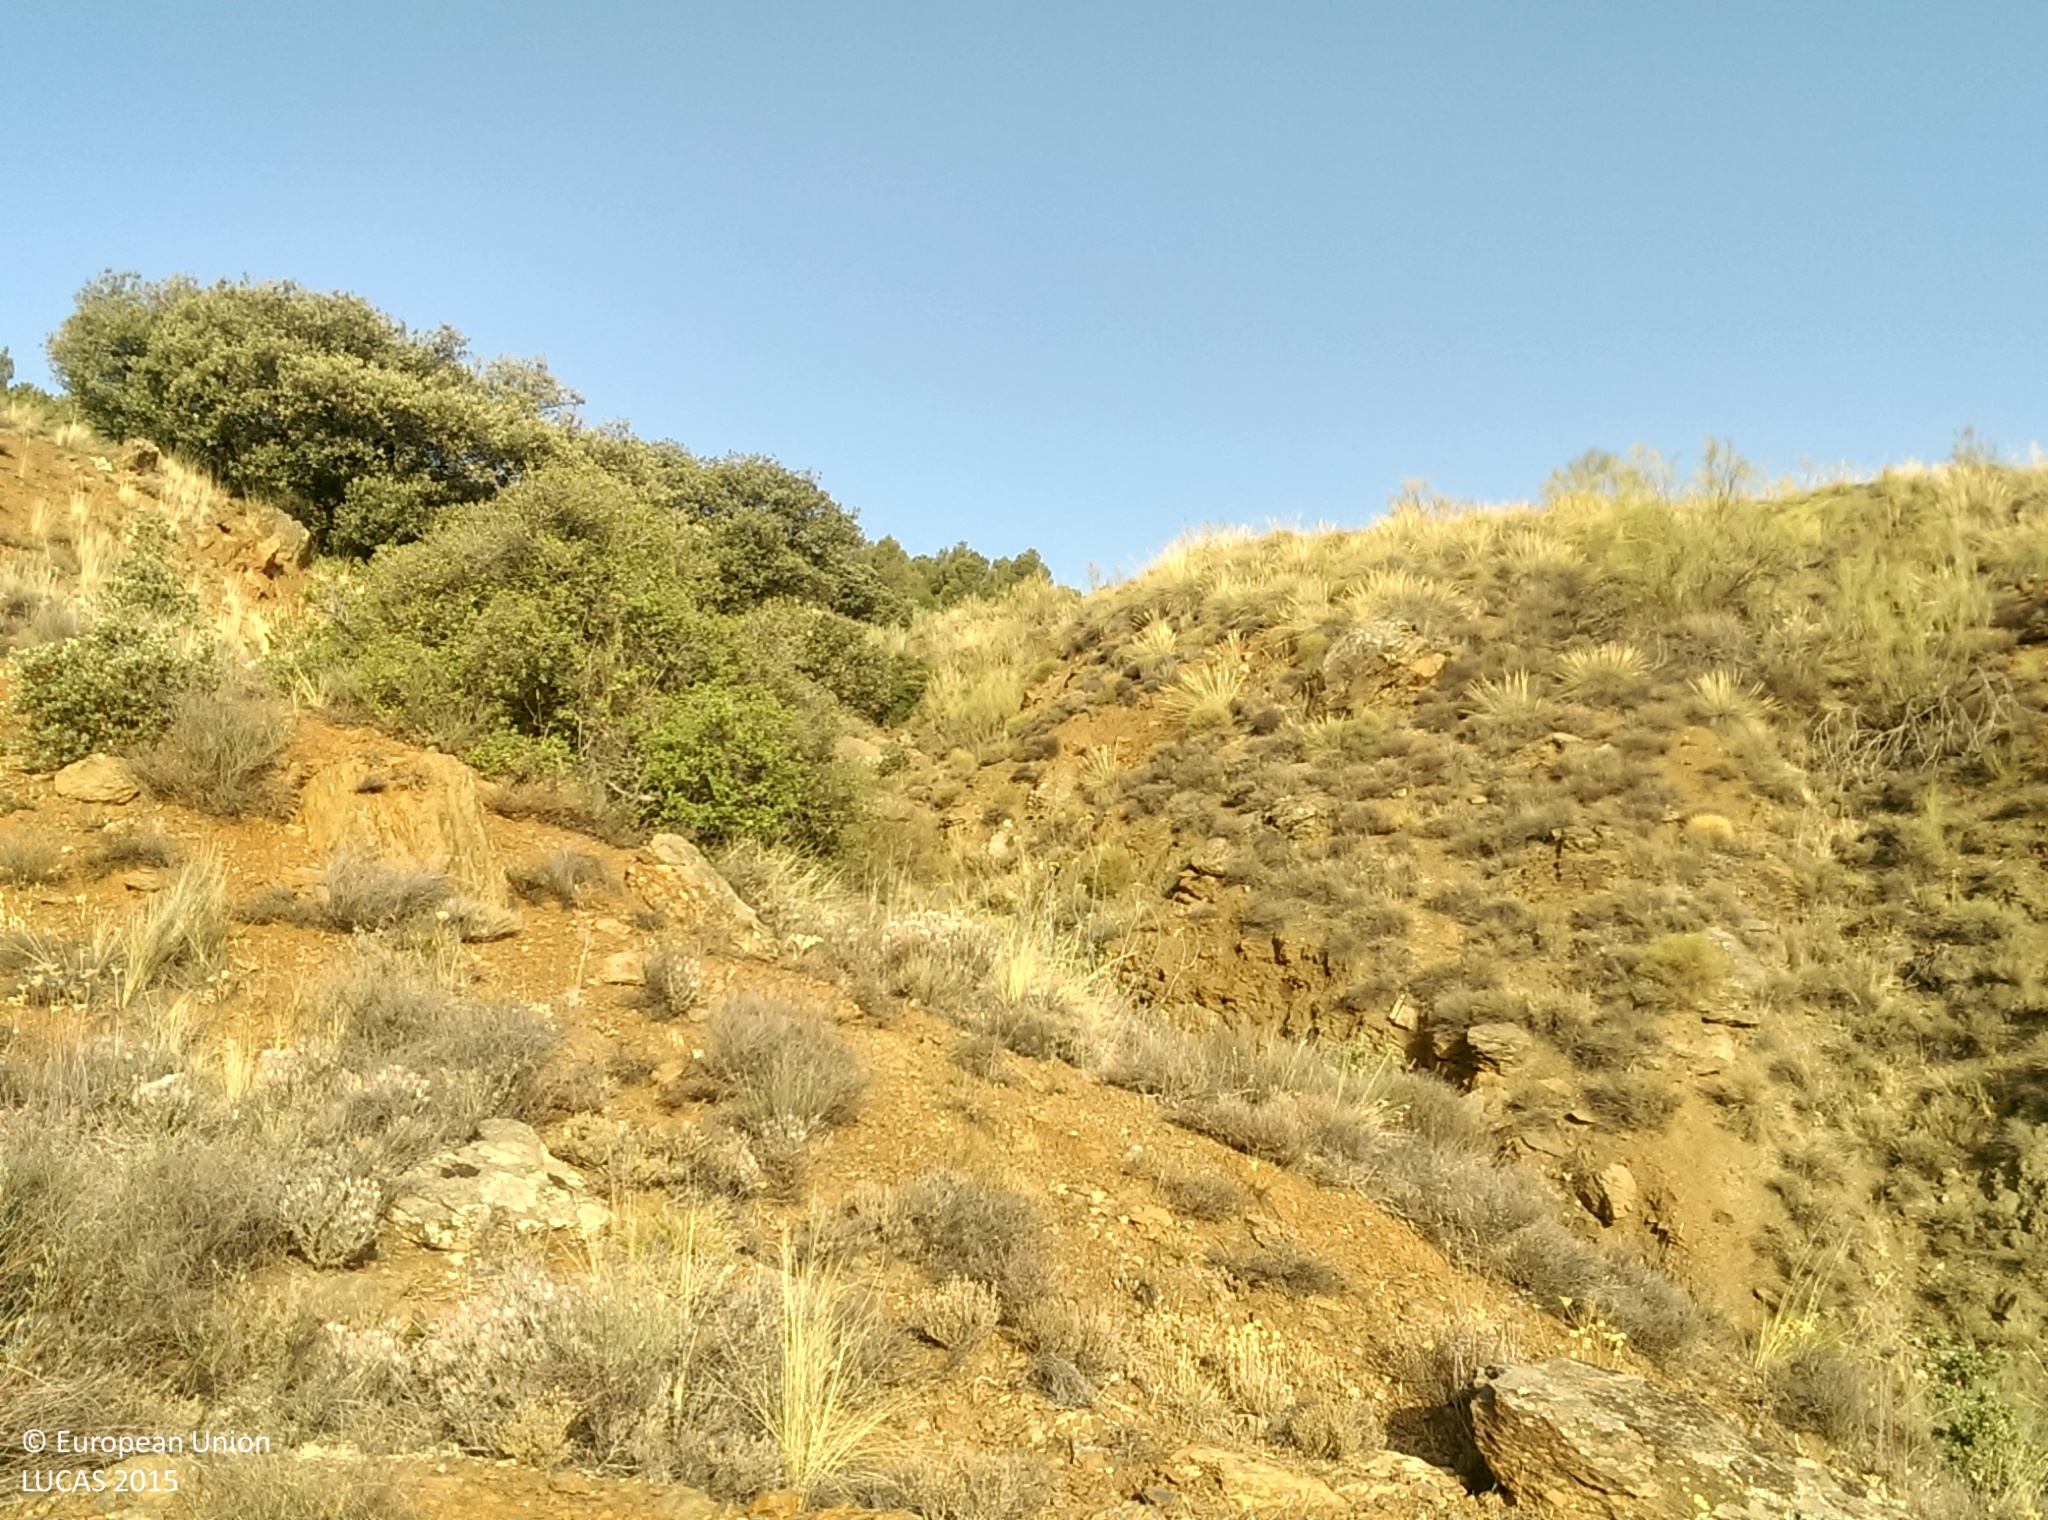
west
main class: Shrubland
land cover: Shrubland without tree cover
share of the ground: 10 - 25 %
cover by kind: herbaceous plants 40 %, unconsolidated bare surface 30 %, shrubs 20 %, consolidated bare surface 10 %
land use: Forestry
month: July
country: ES
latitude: 37.1468
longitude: -2.8511
